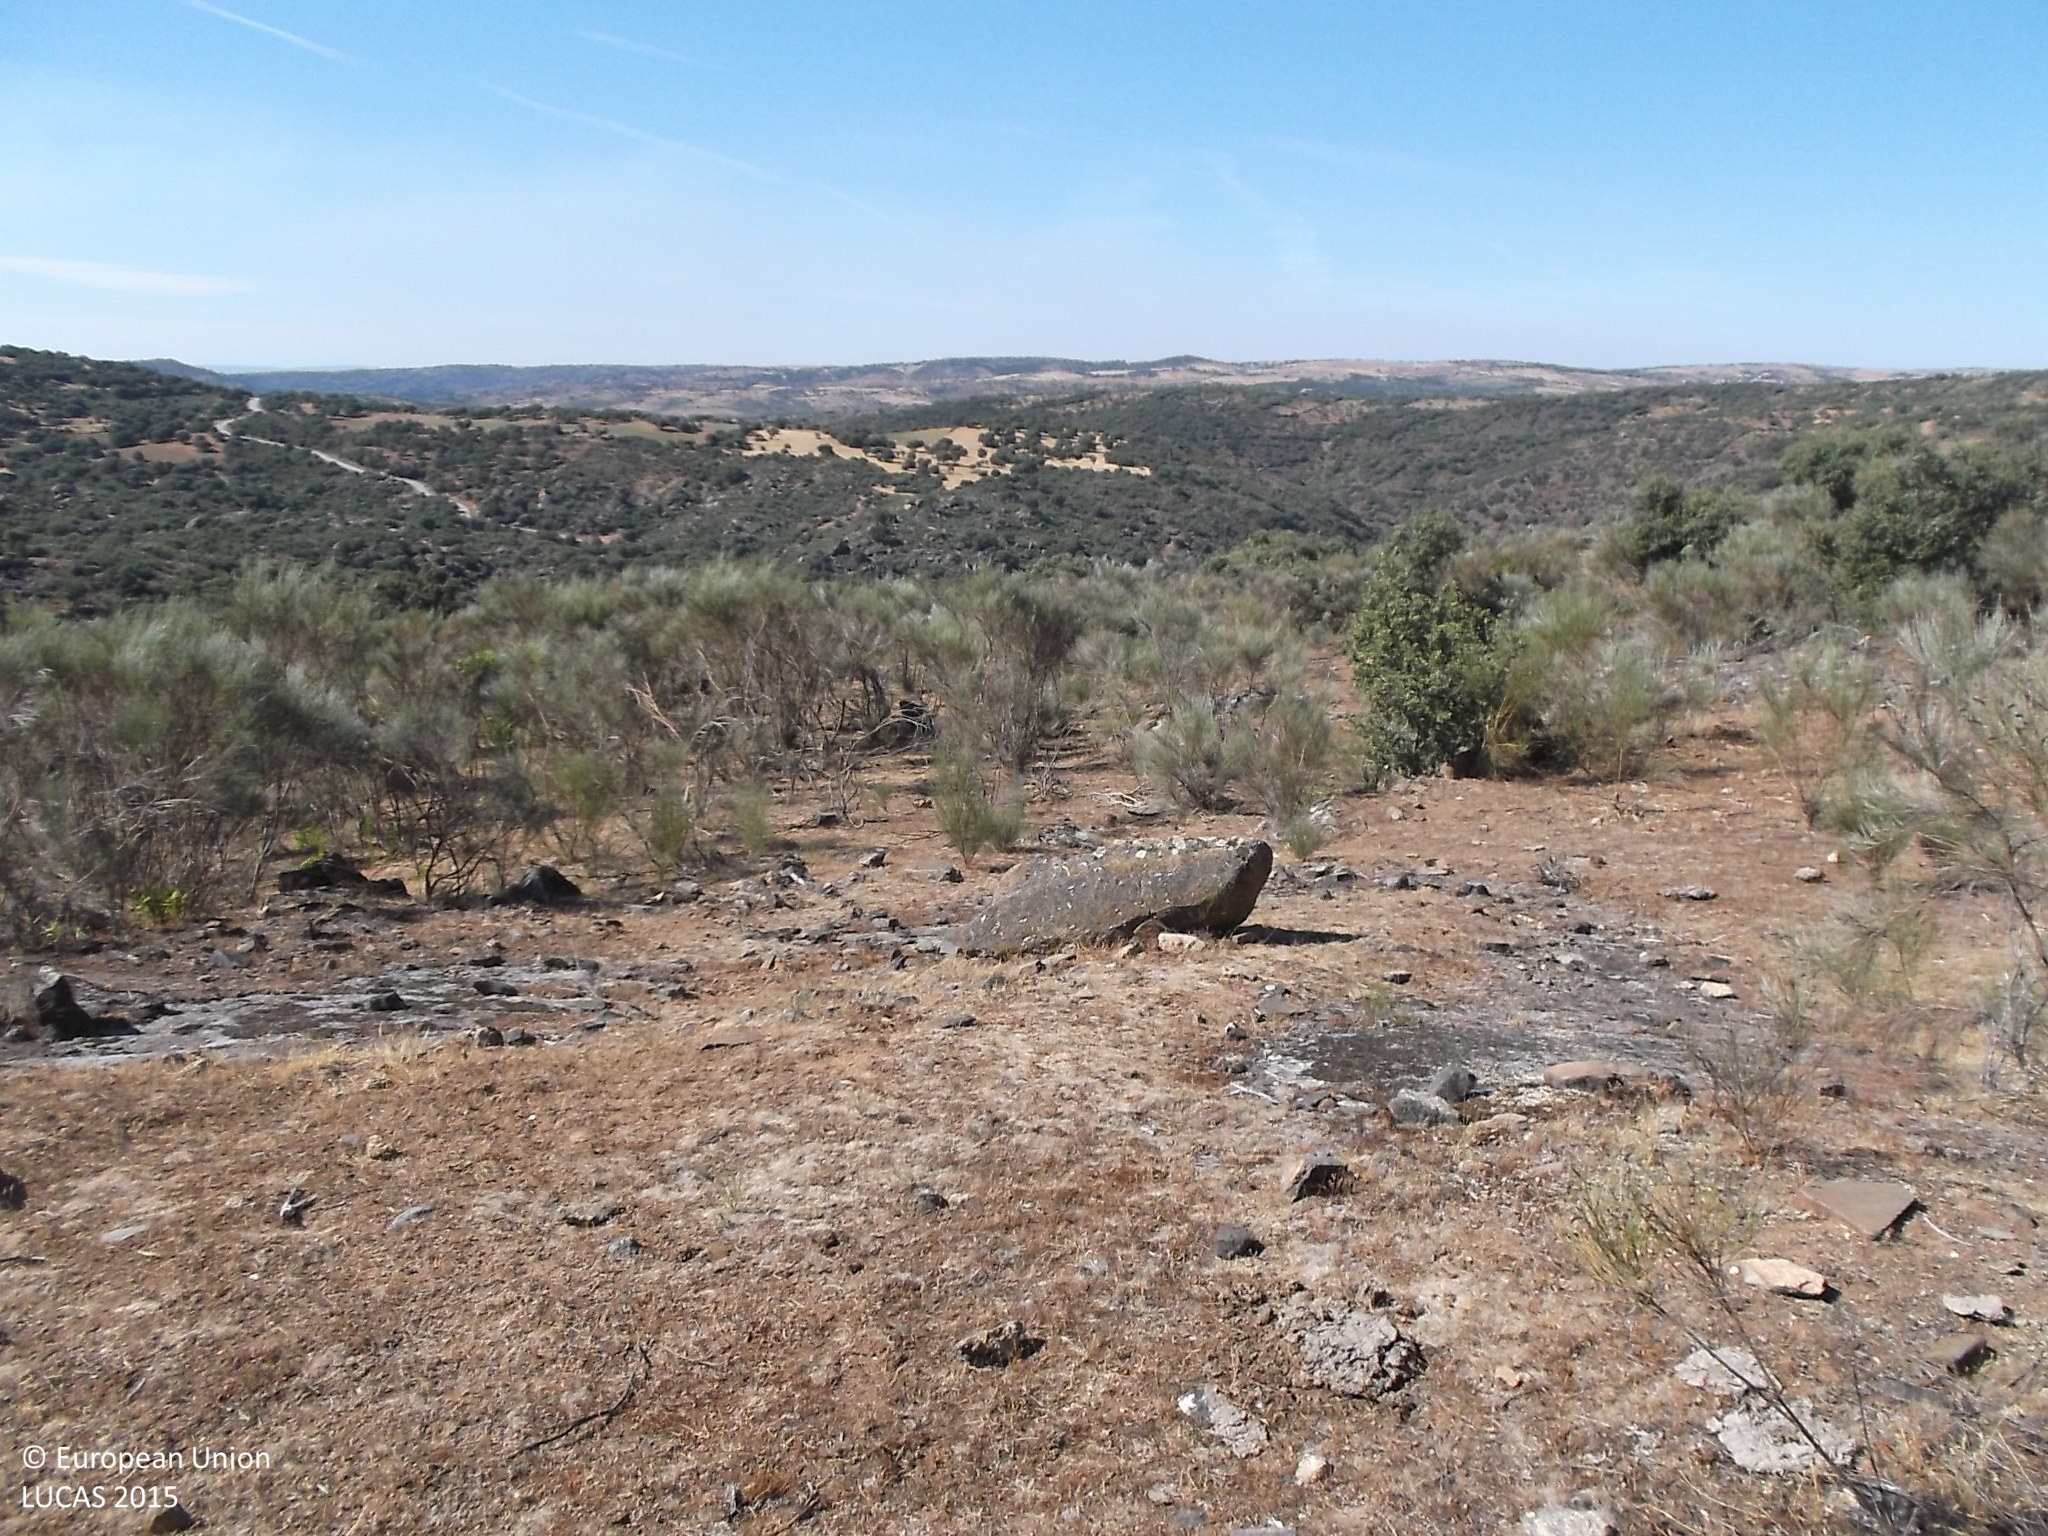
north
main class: Shrubland
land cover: Shrubland without tree cover
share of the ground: > 75 %
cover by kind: shrubs 90 %, consolidated bare surface 10 %
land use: Agriculture (excluding fallow land and kitchen gardens)
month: July
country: ES
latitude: 40.8188
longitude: -6.7803
